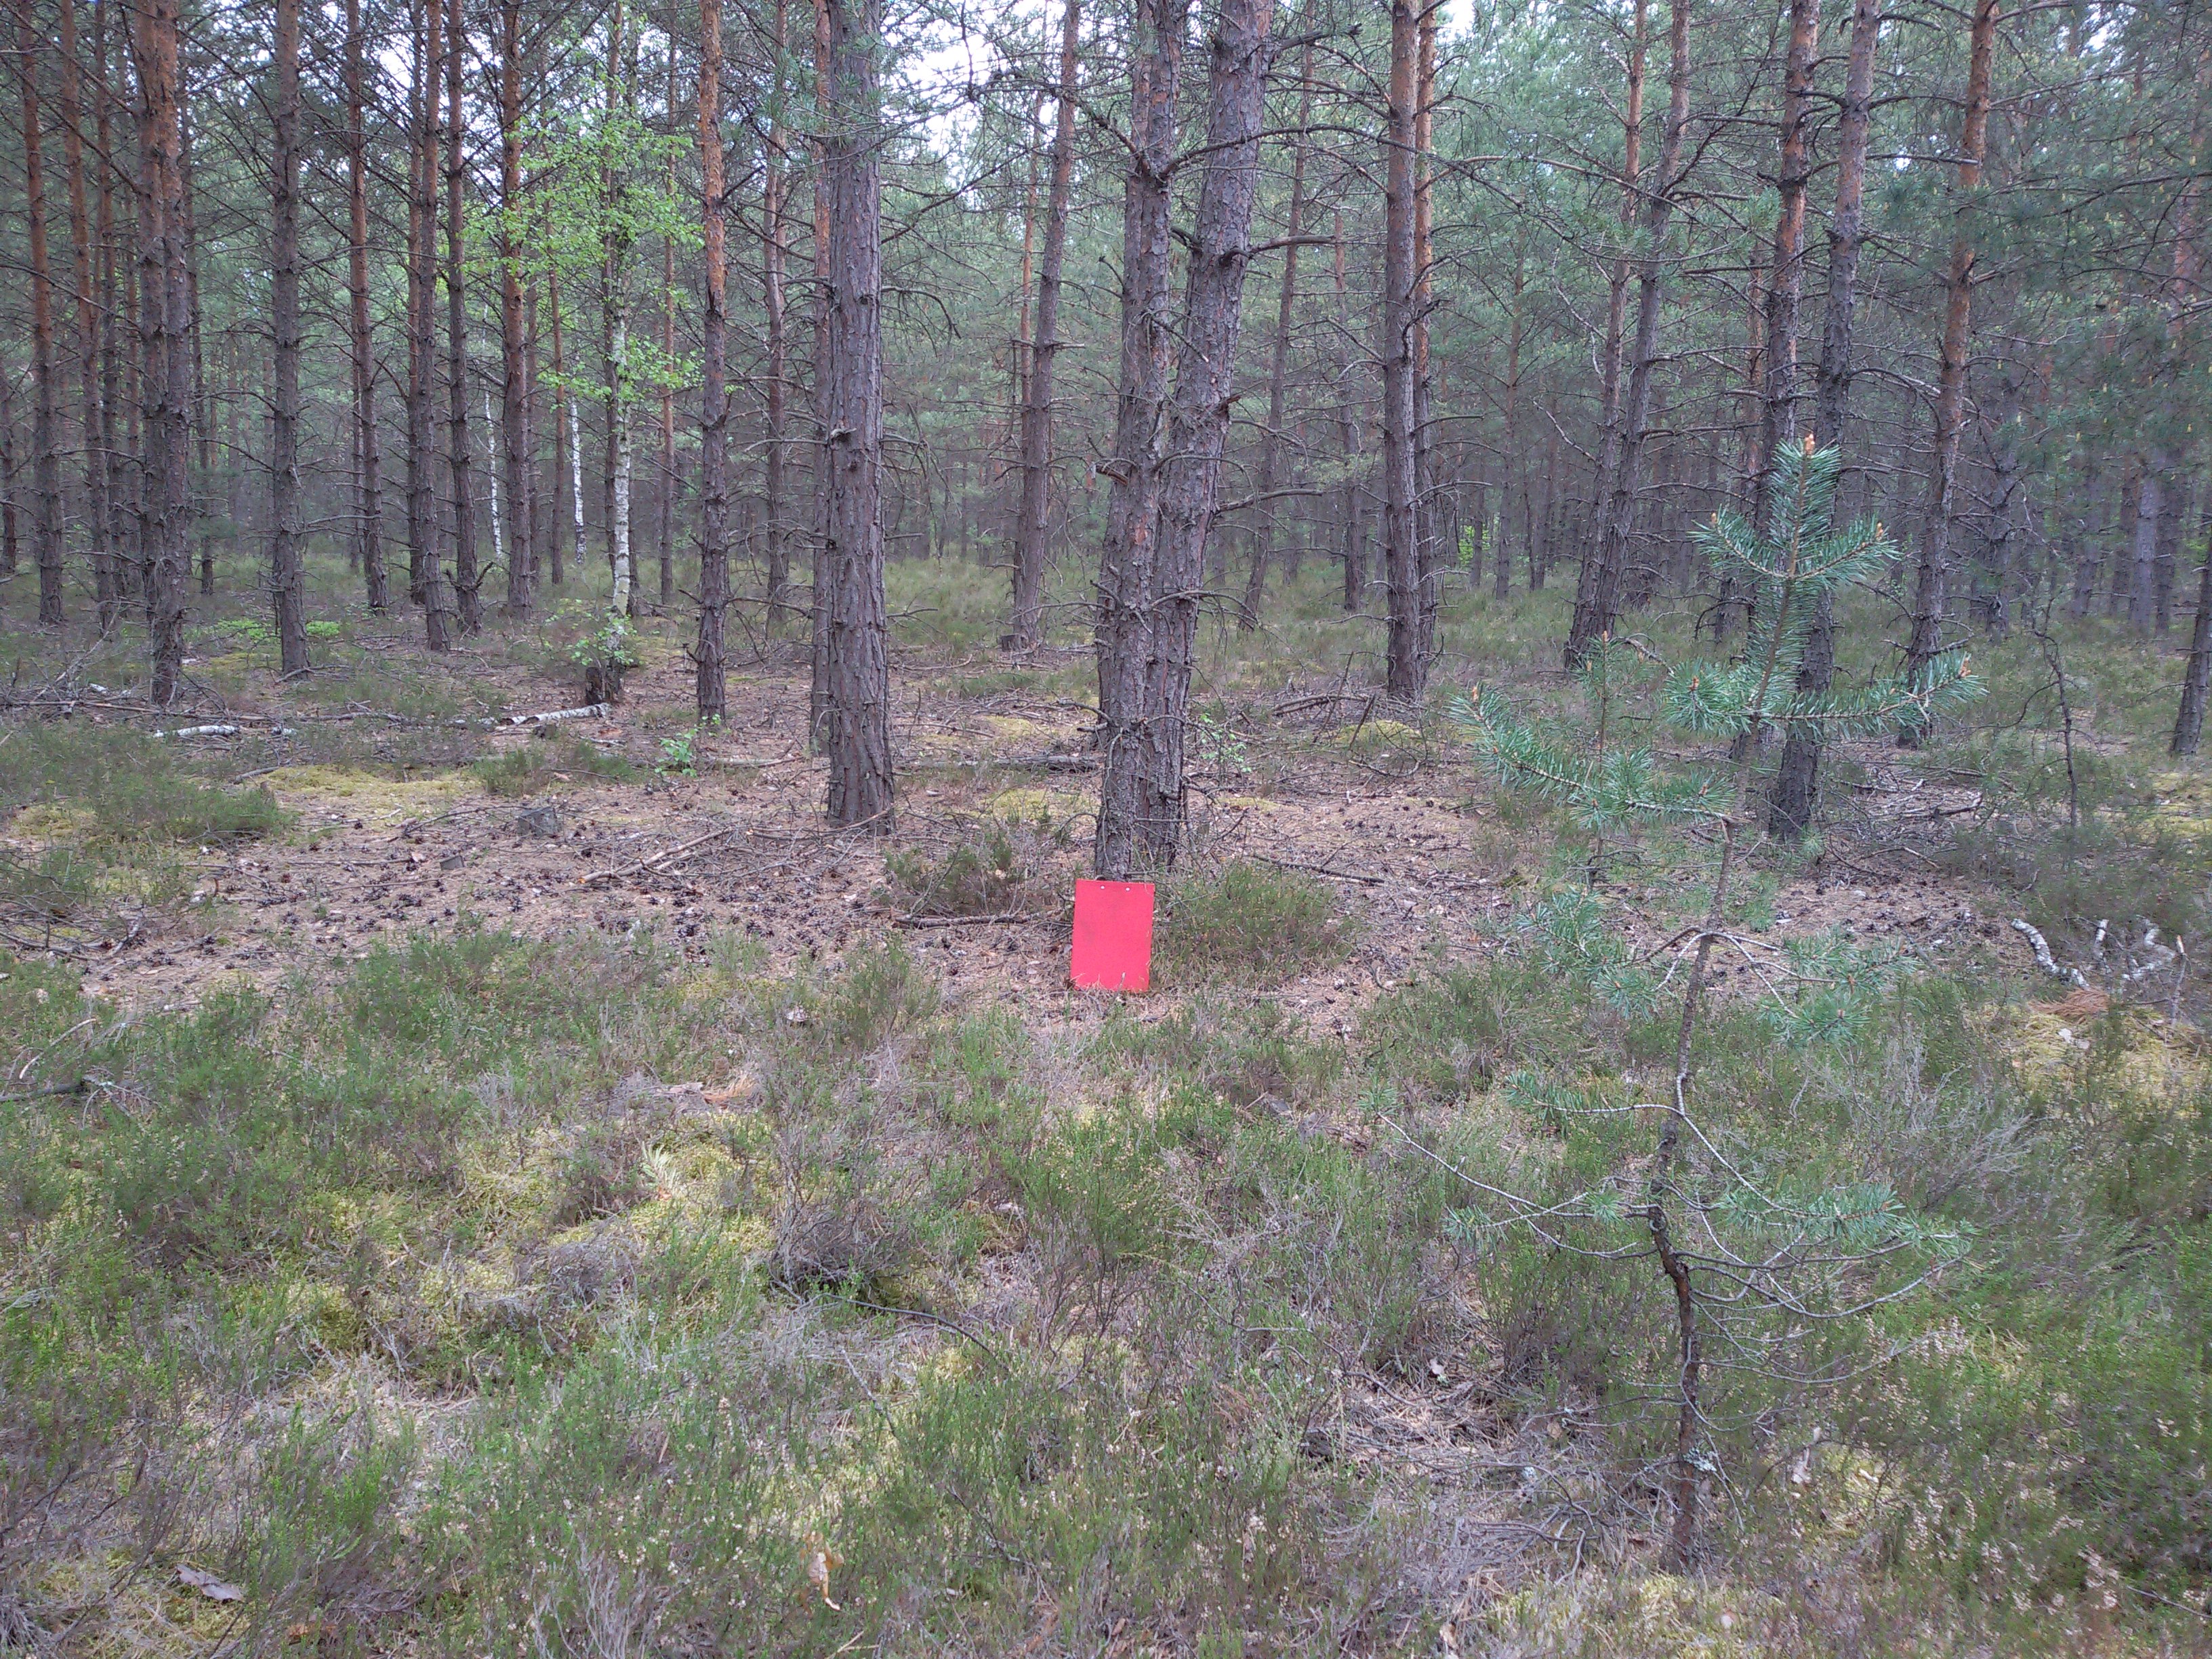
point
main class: Woodland
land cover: Pine dominated coniferous woodland
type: hemiboreal forest and nemoral coniferous forest and mixed broadleaved-coniferous forest
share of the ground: 50 - 75 %
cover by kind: coniferous forest trees 70 %, herbaceous plants 15 %, lichens and mosses 10 %, unconsolidated bare surface 5 %
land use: Forestry
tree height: > 5 m
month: May
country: PL
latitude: 51.4454
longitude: 15.7459
